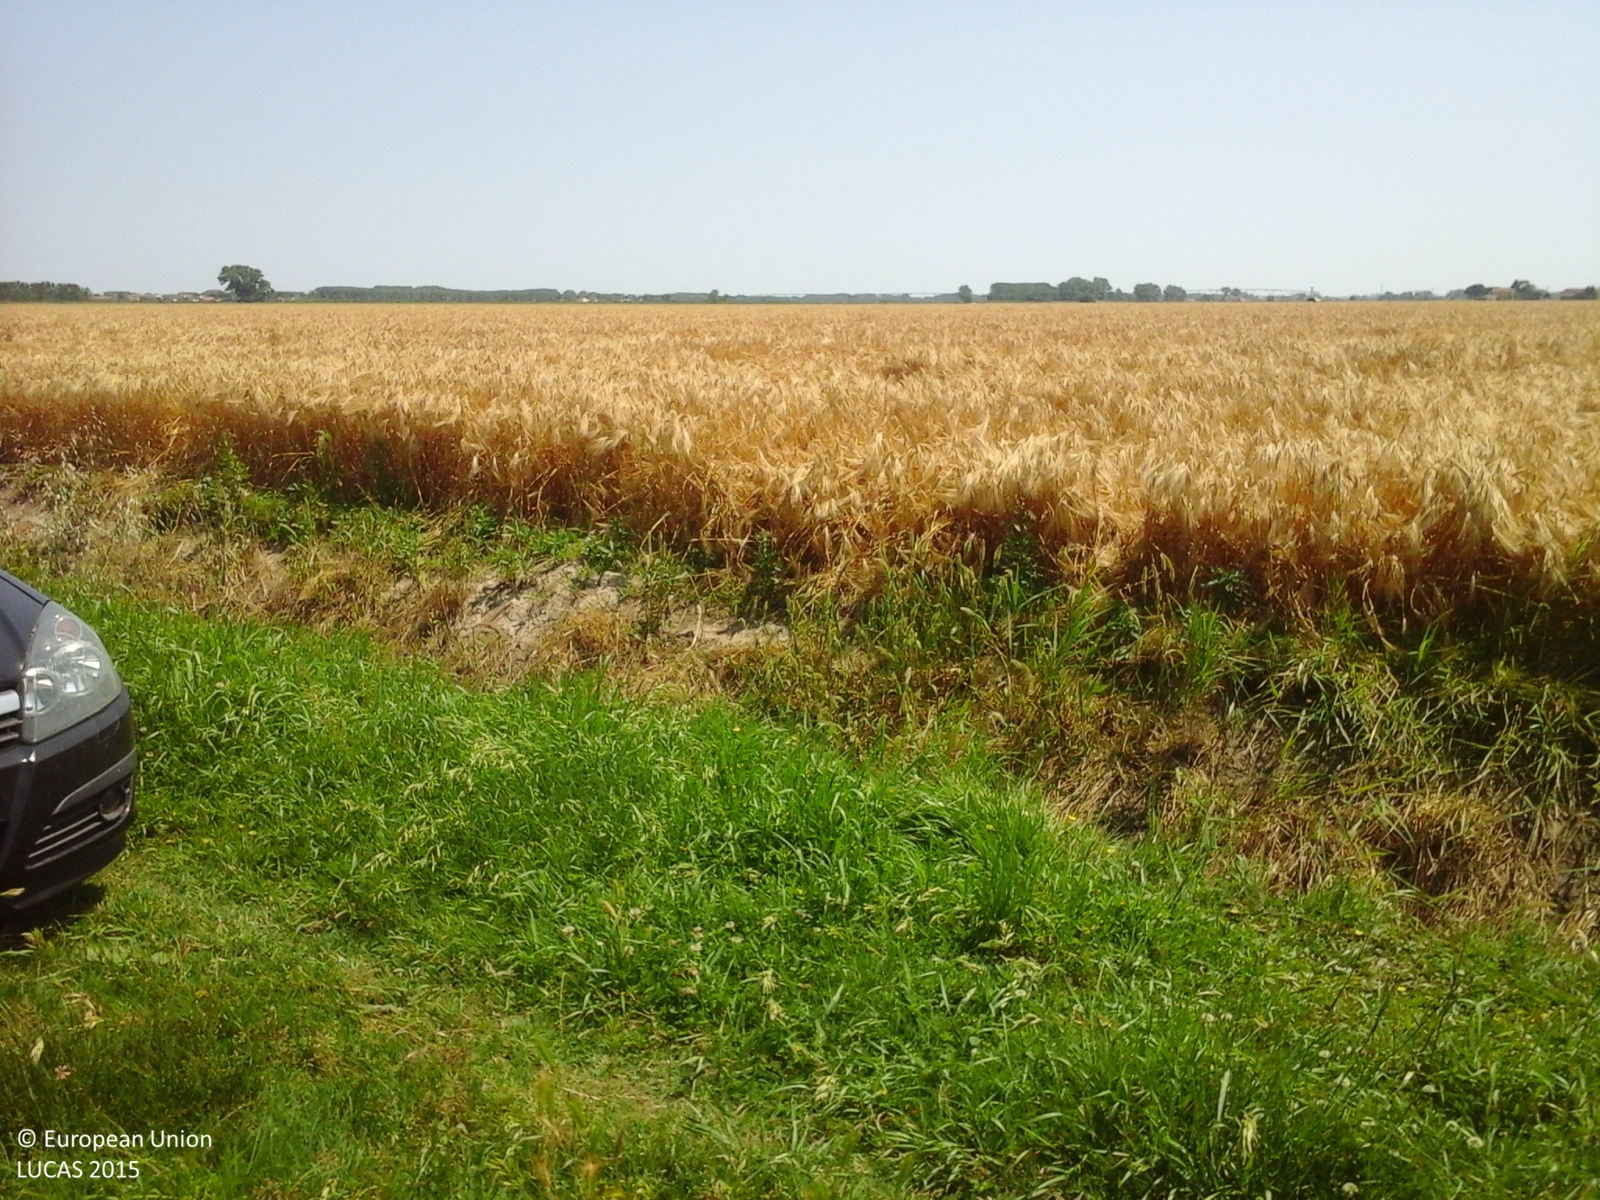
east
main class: Cropland
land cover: Common wheat
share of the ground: > 75 %
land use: Agriculture (excluding fallow land and kitchen gardens)
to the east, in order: Common wheat; Grass margins; Ditches and canals; Grass margins; Common wheat
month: June
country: IT
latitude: 44.7246
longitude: 12.1799
